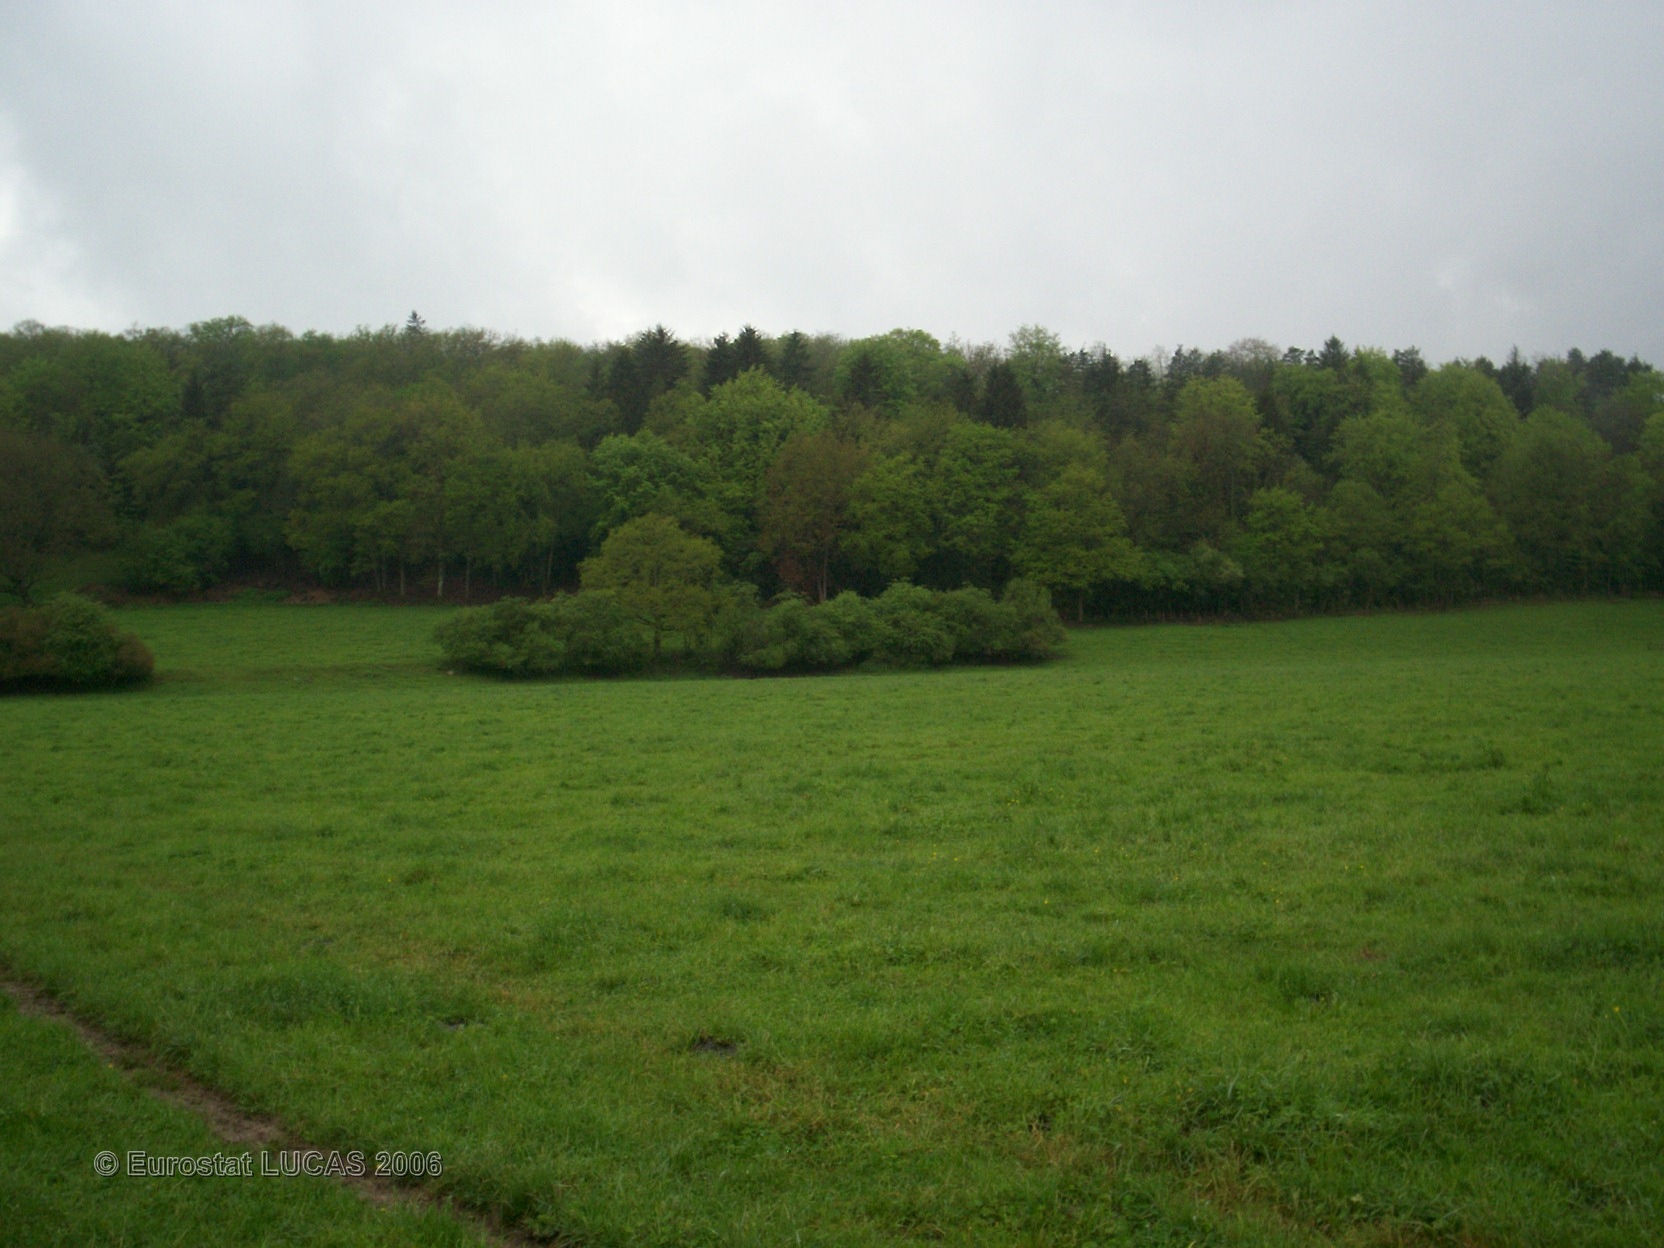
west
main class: Grassland
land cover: Grassland without tree/shrub cover
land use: Agriculture (excluding fallow land and kitchen gardens)
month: May
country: FR
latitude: 47.7650
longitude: 4.5684
